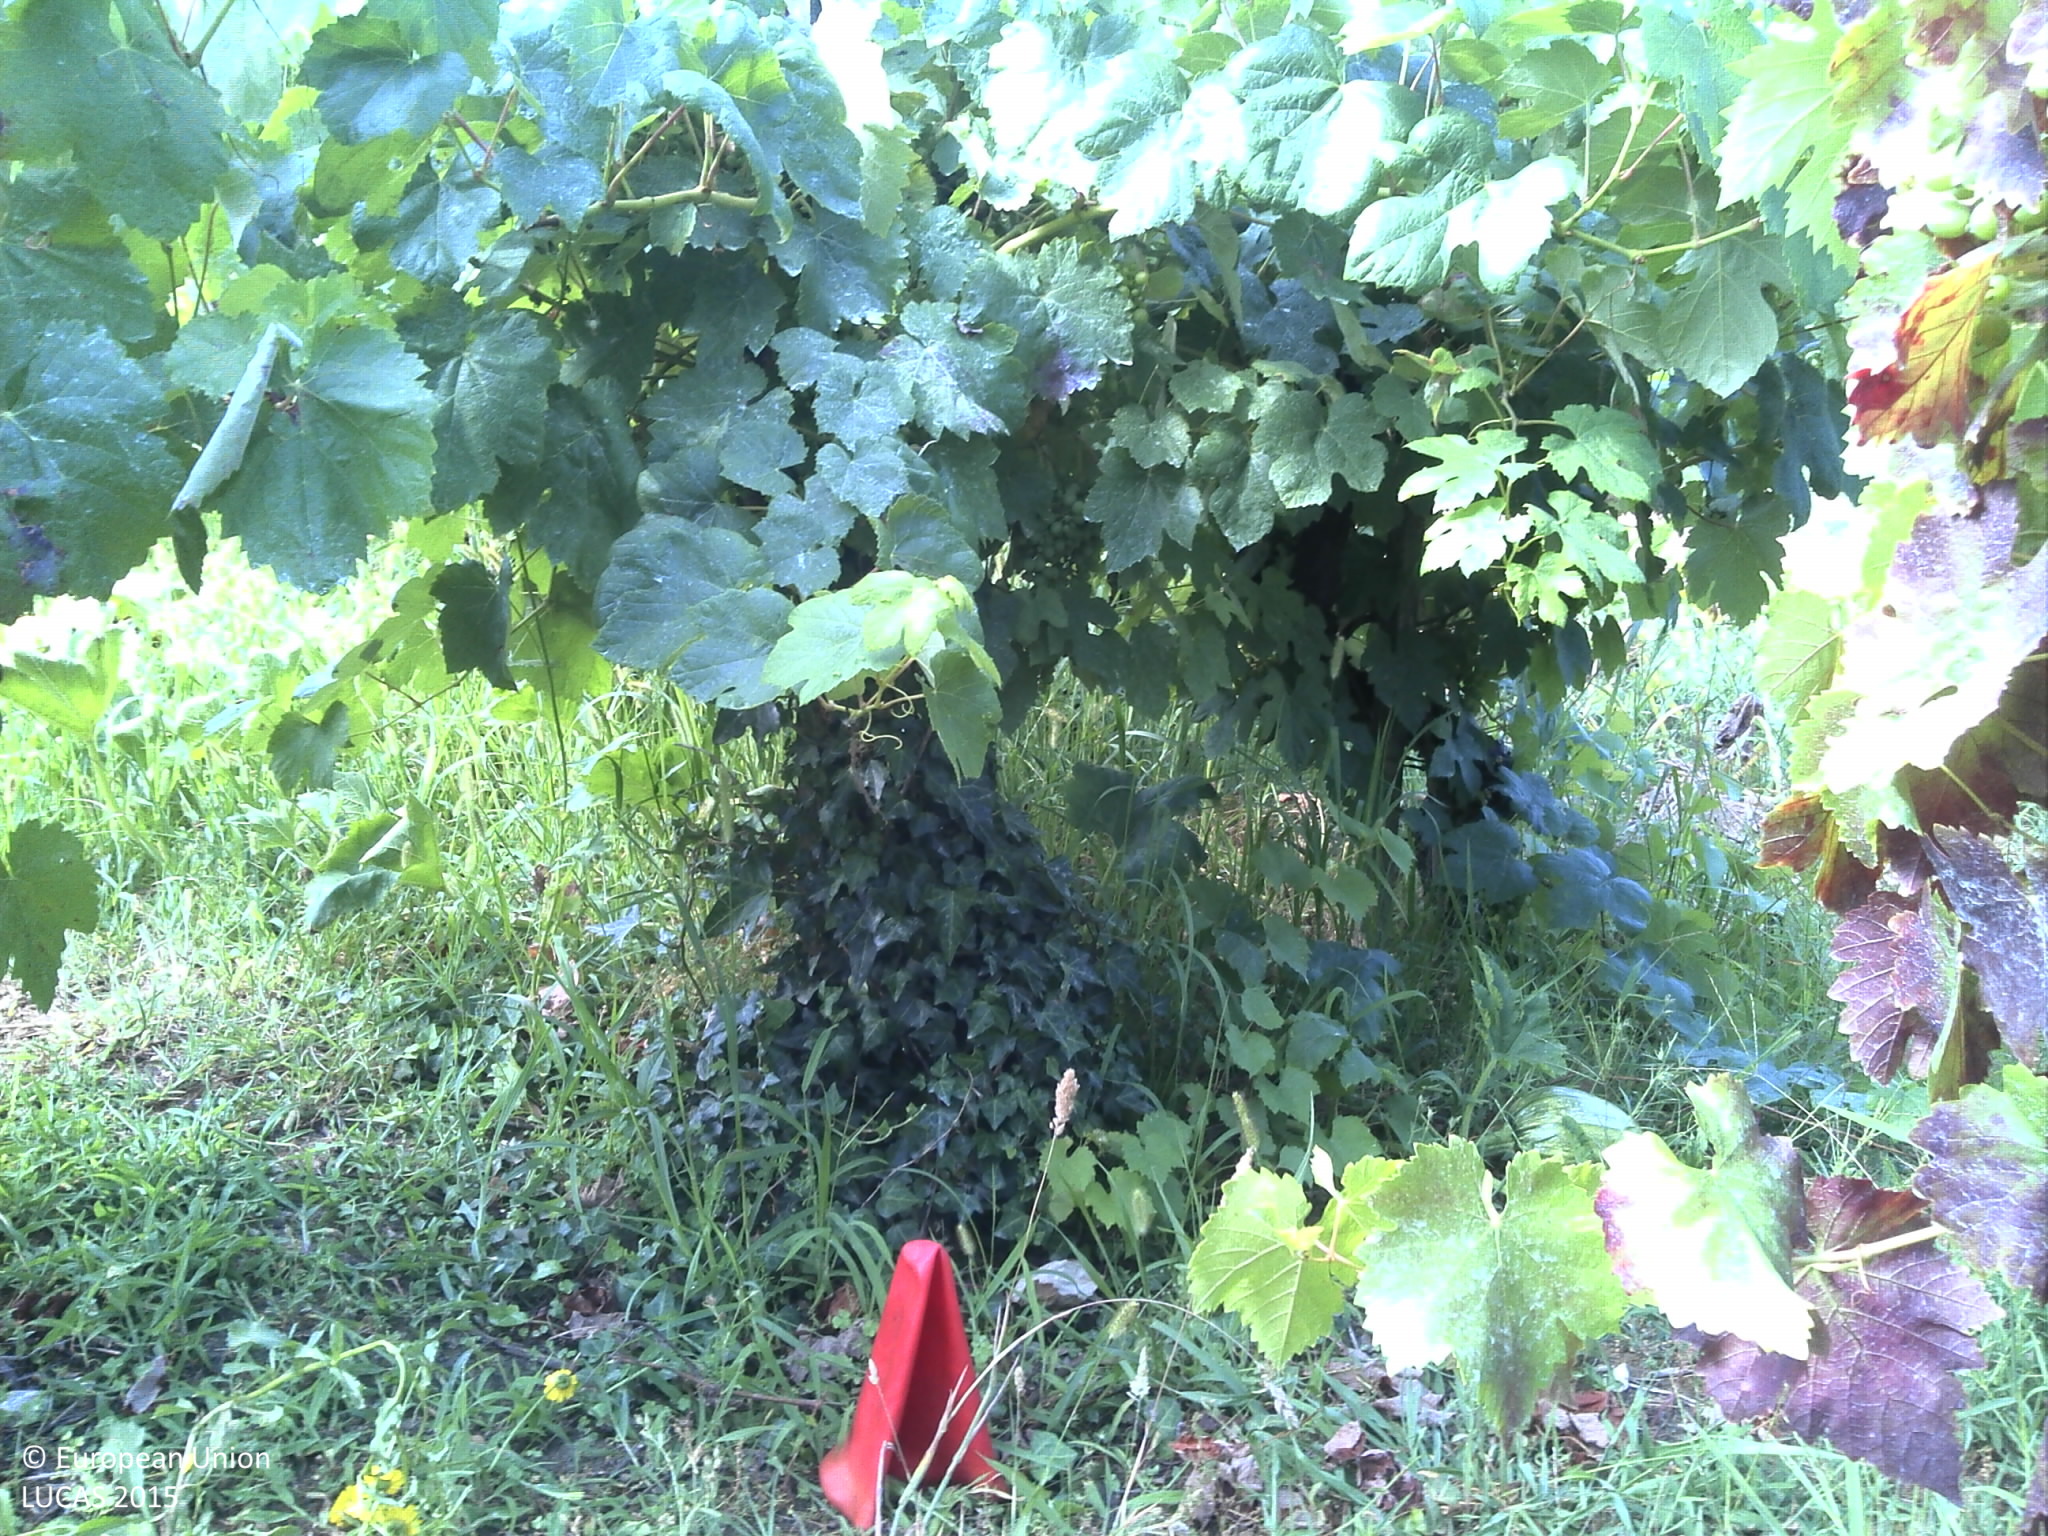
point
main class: Cropland
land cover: Vineyards
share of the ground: 25 - 50 %
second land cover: Grassland without tree/shrub cover
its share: > 75 %
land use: Agriculture (excluding fallow land and kitchen gardens)
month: July
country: PT
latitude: 40.6315
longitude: -8.4282
